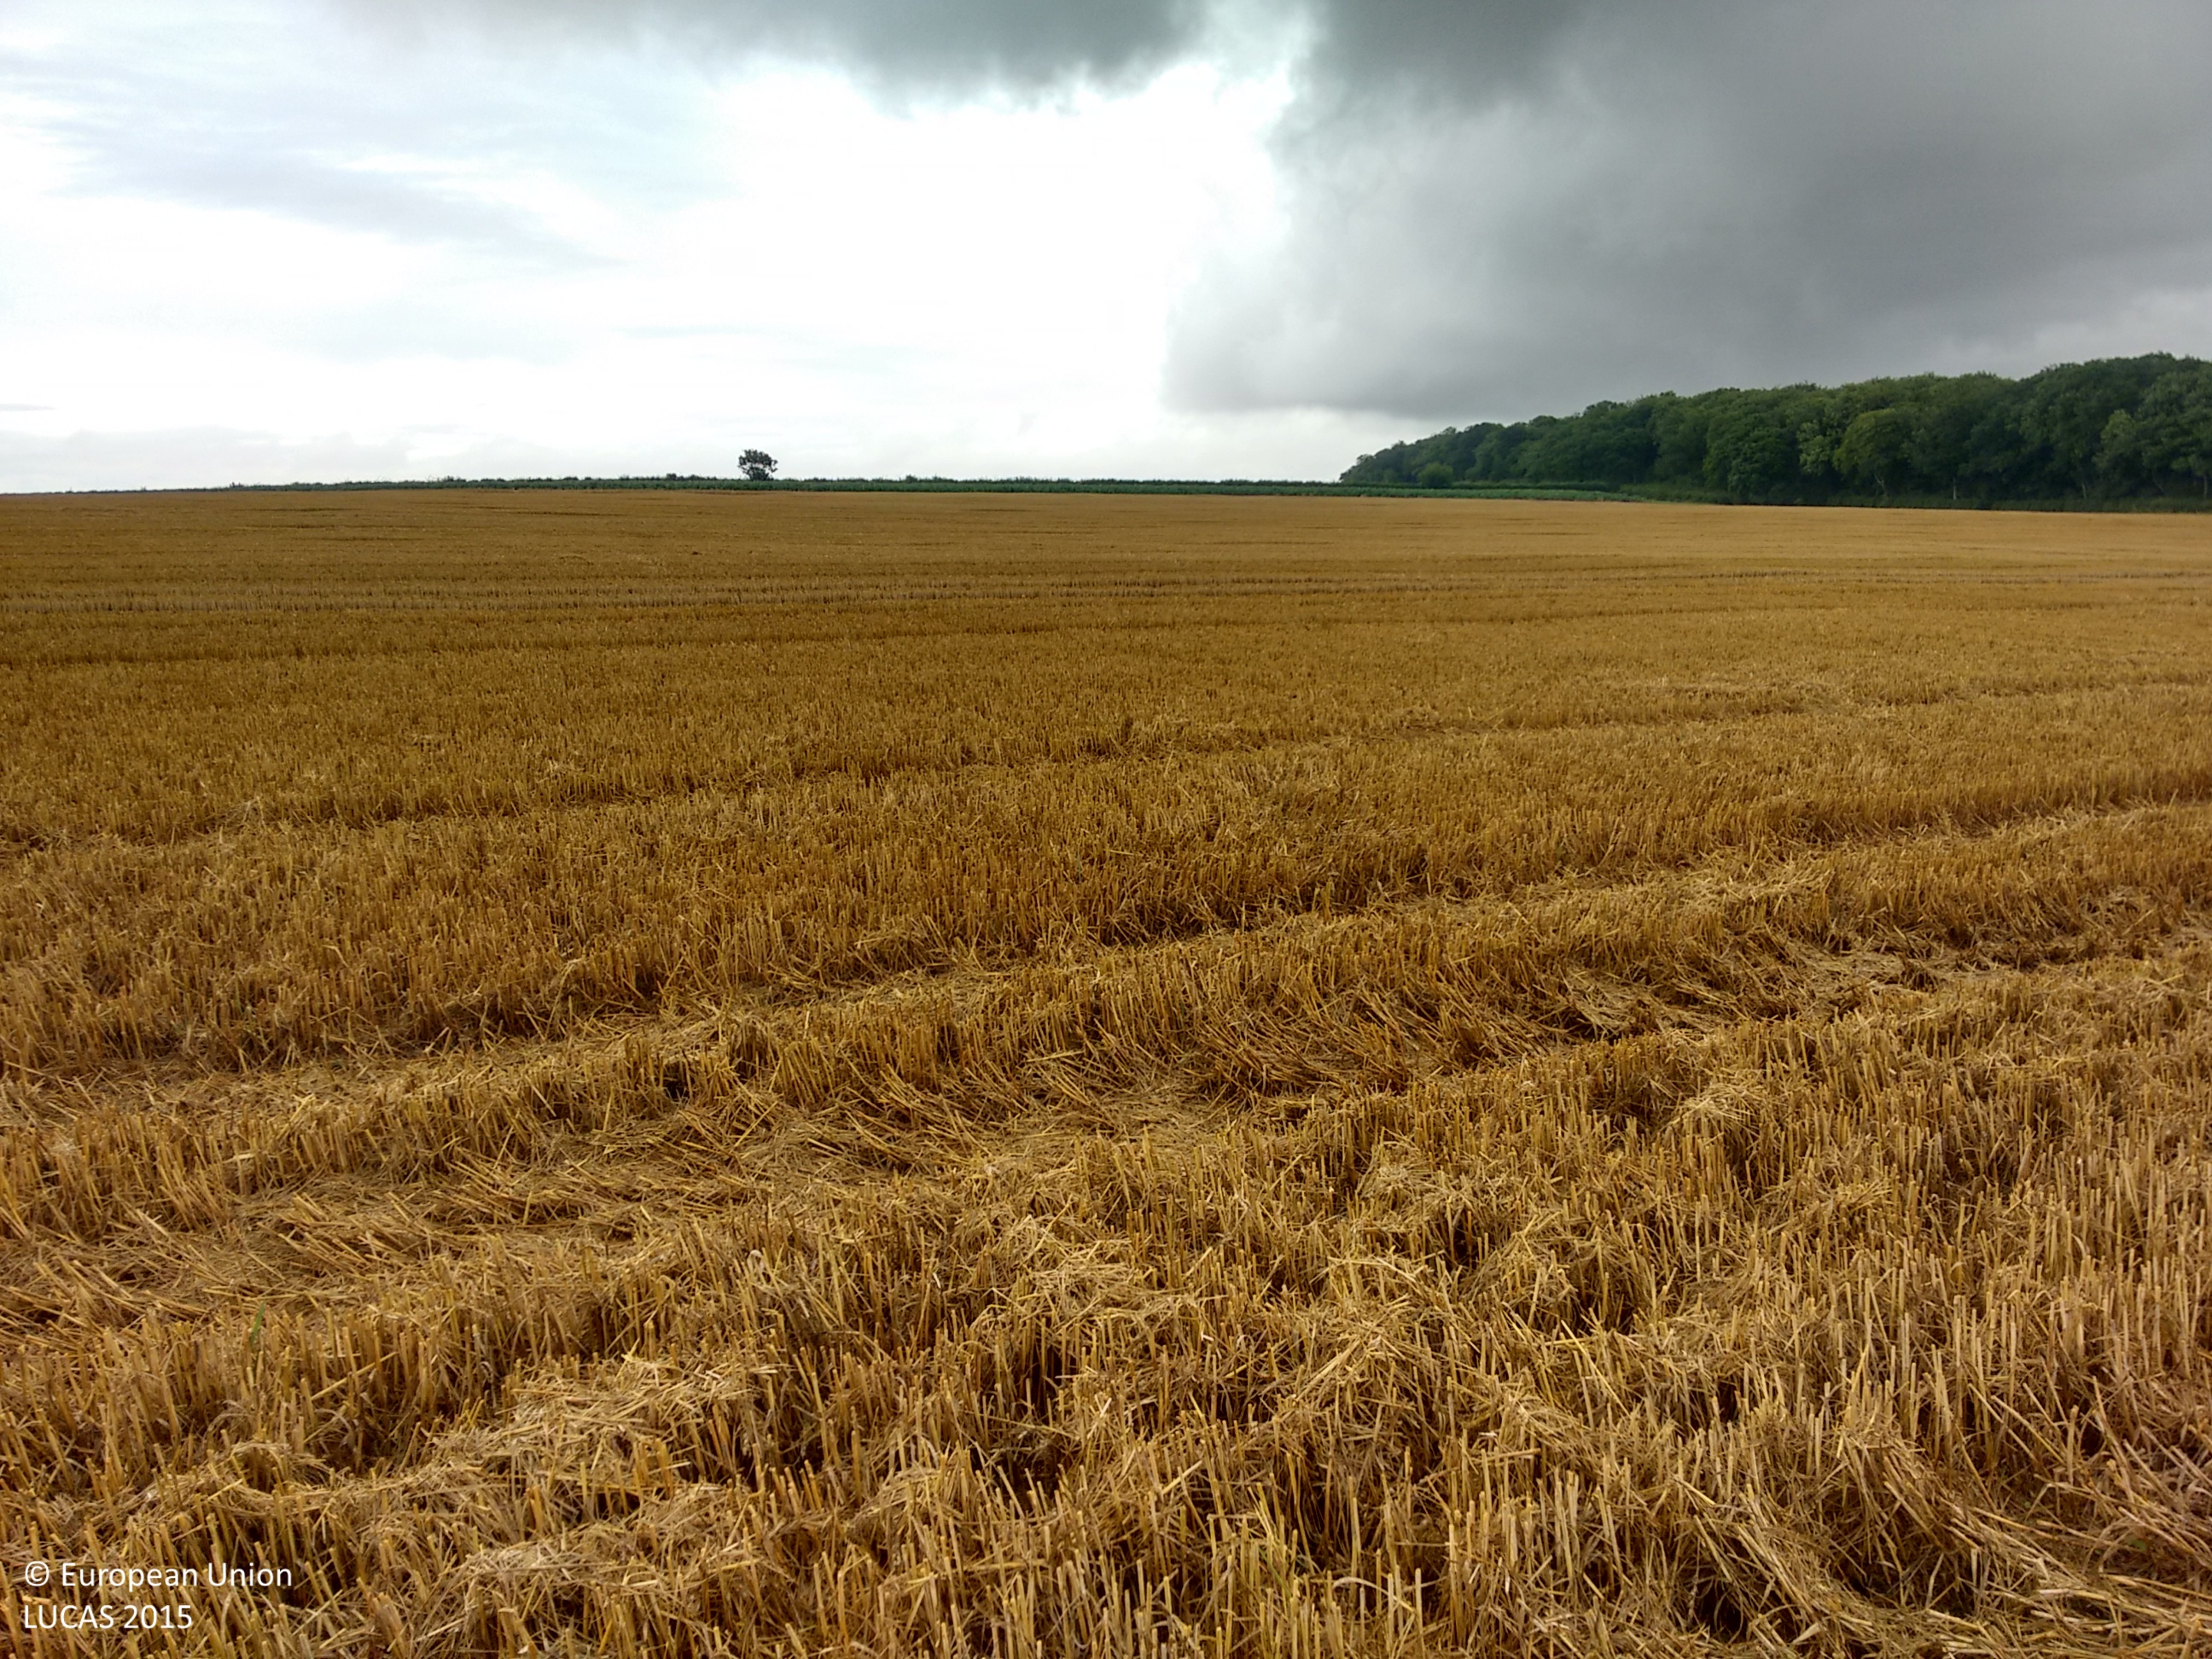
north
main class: Cropland
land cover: Common wheat
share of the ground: > 75 %
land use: Agriculture (excluding fallow land and kitchen gardens)
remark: Harvested field
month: August
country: GB
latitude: 52.1196
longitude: 0.4642
